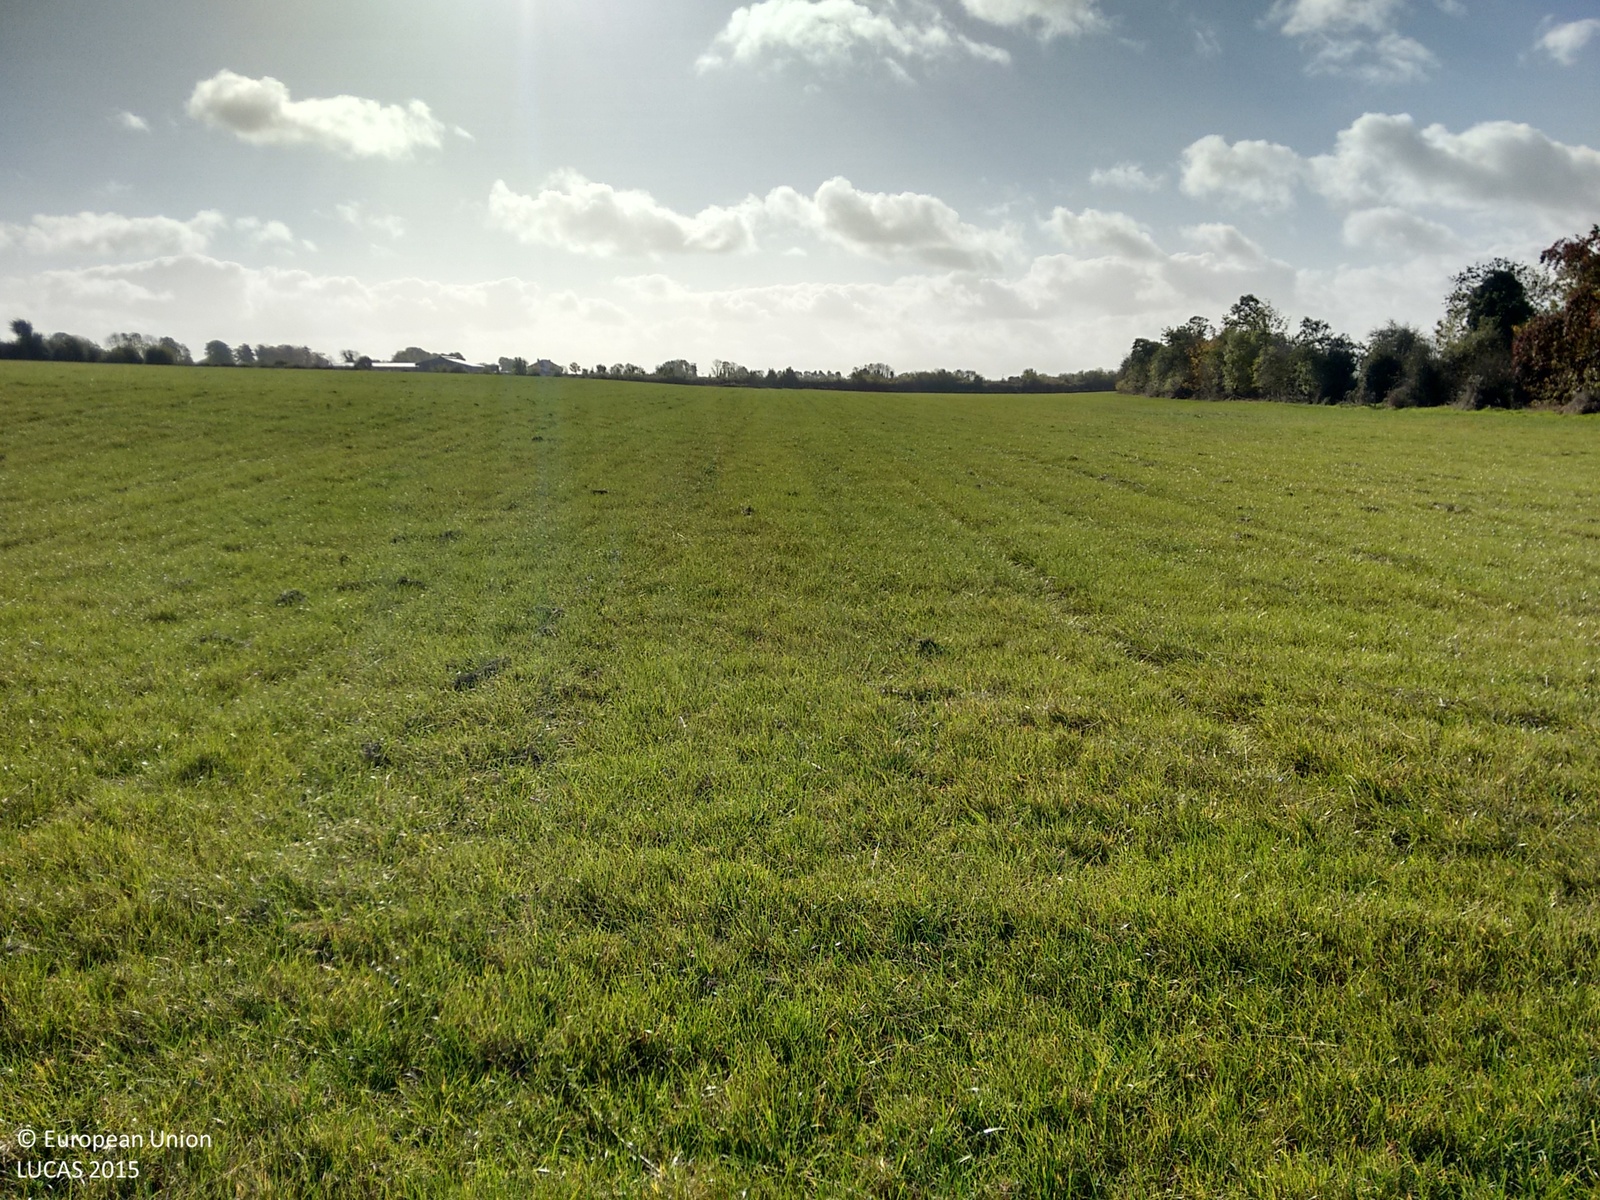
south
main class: Grassland
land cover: Grassland without tree/shrub cover
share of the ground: > 75 %
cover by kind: herbaceous plants 100 %
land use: Agriculture (excluding fallow land and kitchen gardens)
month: October
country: IE
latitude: 52.8038
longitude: -7.8060
